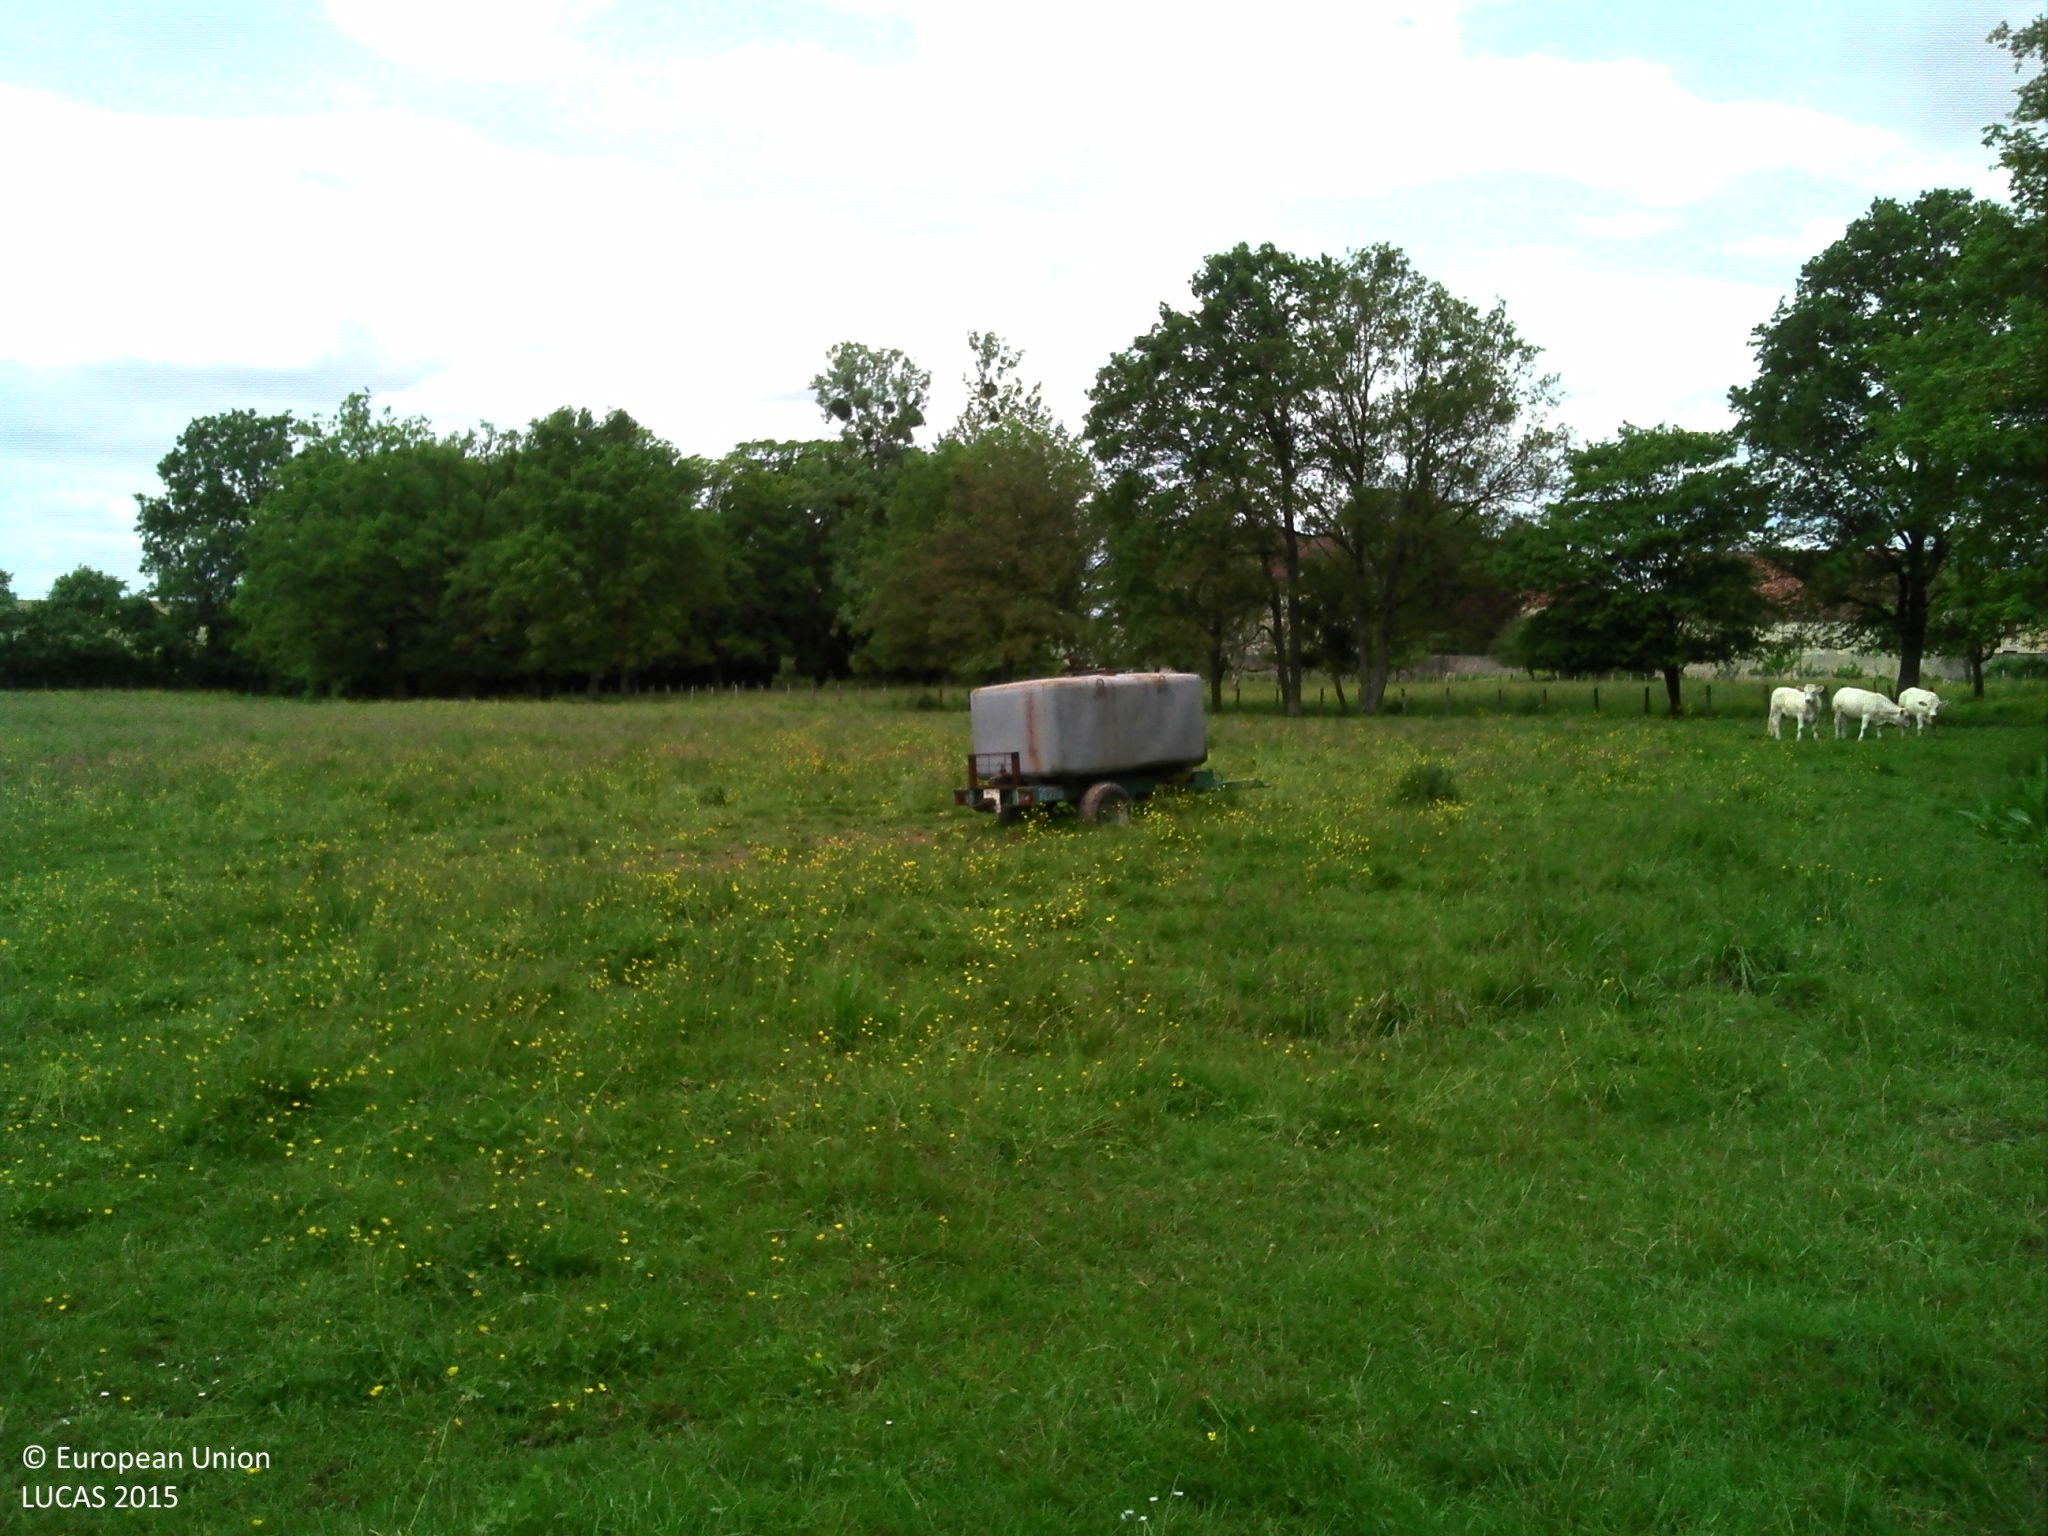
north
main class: Grassland
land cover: Grassland without tree/shrub cover
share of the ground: > 75 %
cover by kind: herbaceous plants 95 %, shrubs 5 %
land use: Agriculture (excluding fallow land and kitchen gardens)
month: May
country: FR
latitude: 47.4010
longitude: 5.2703
